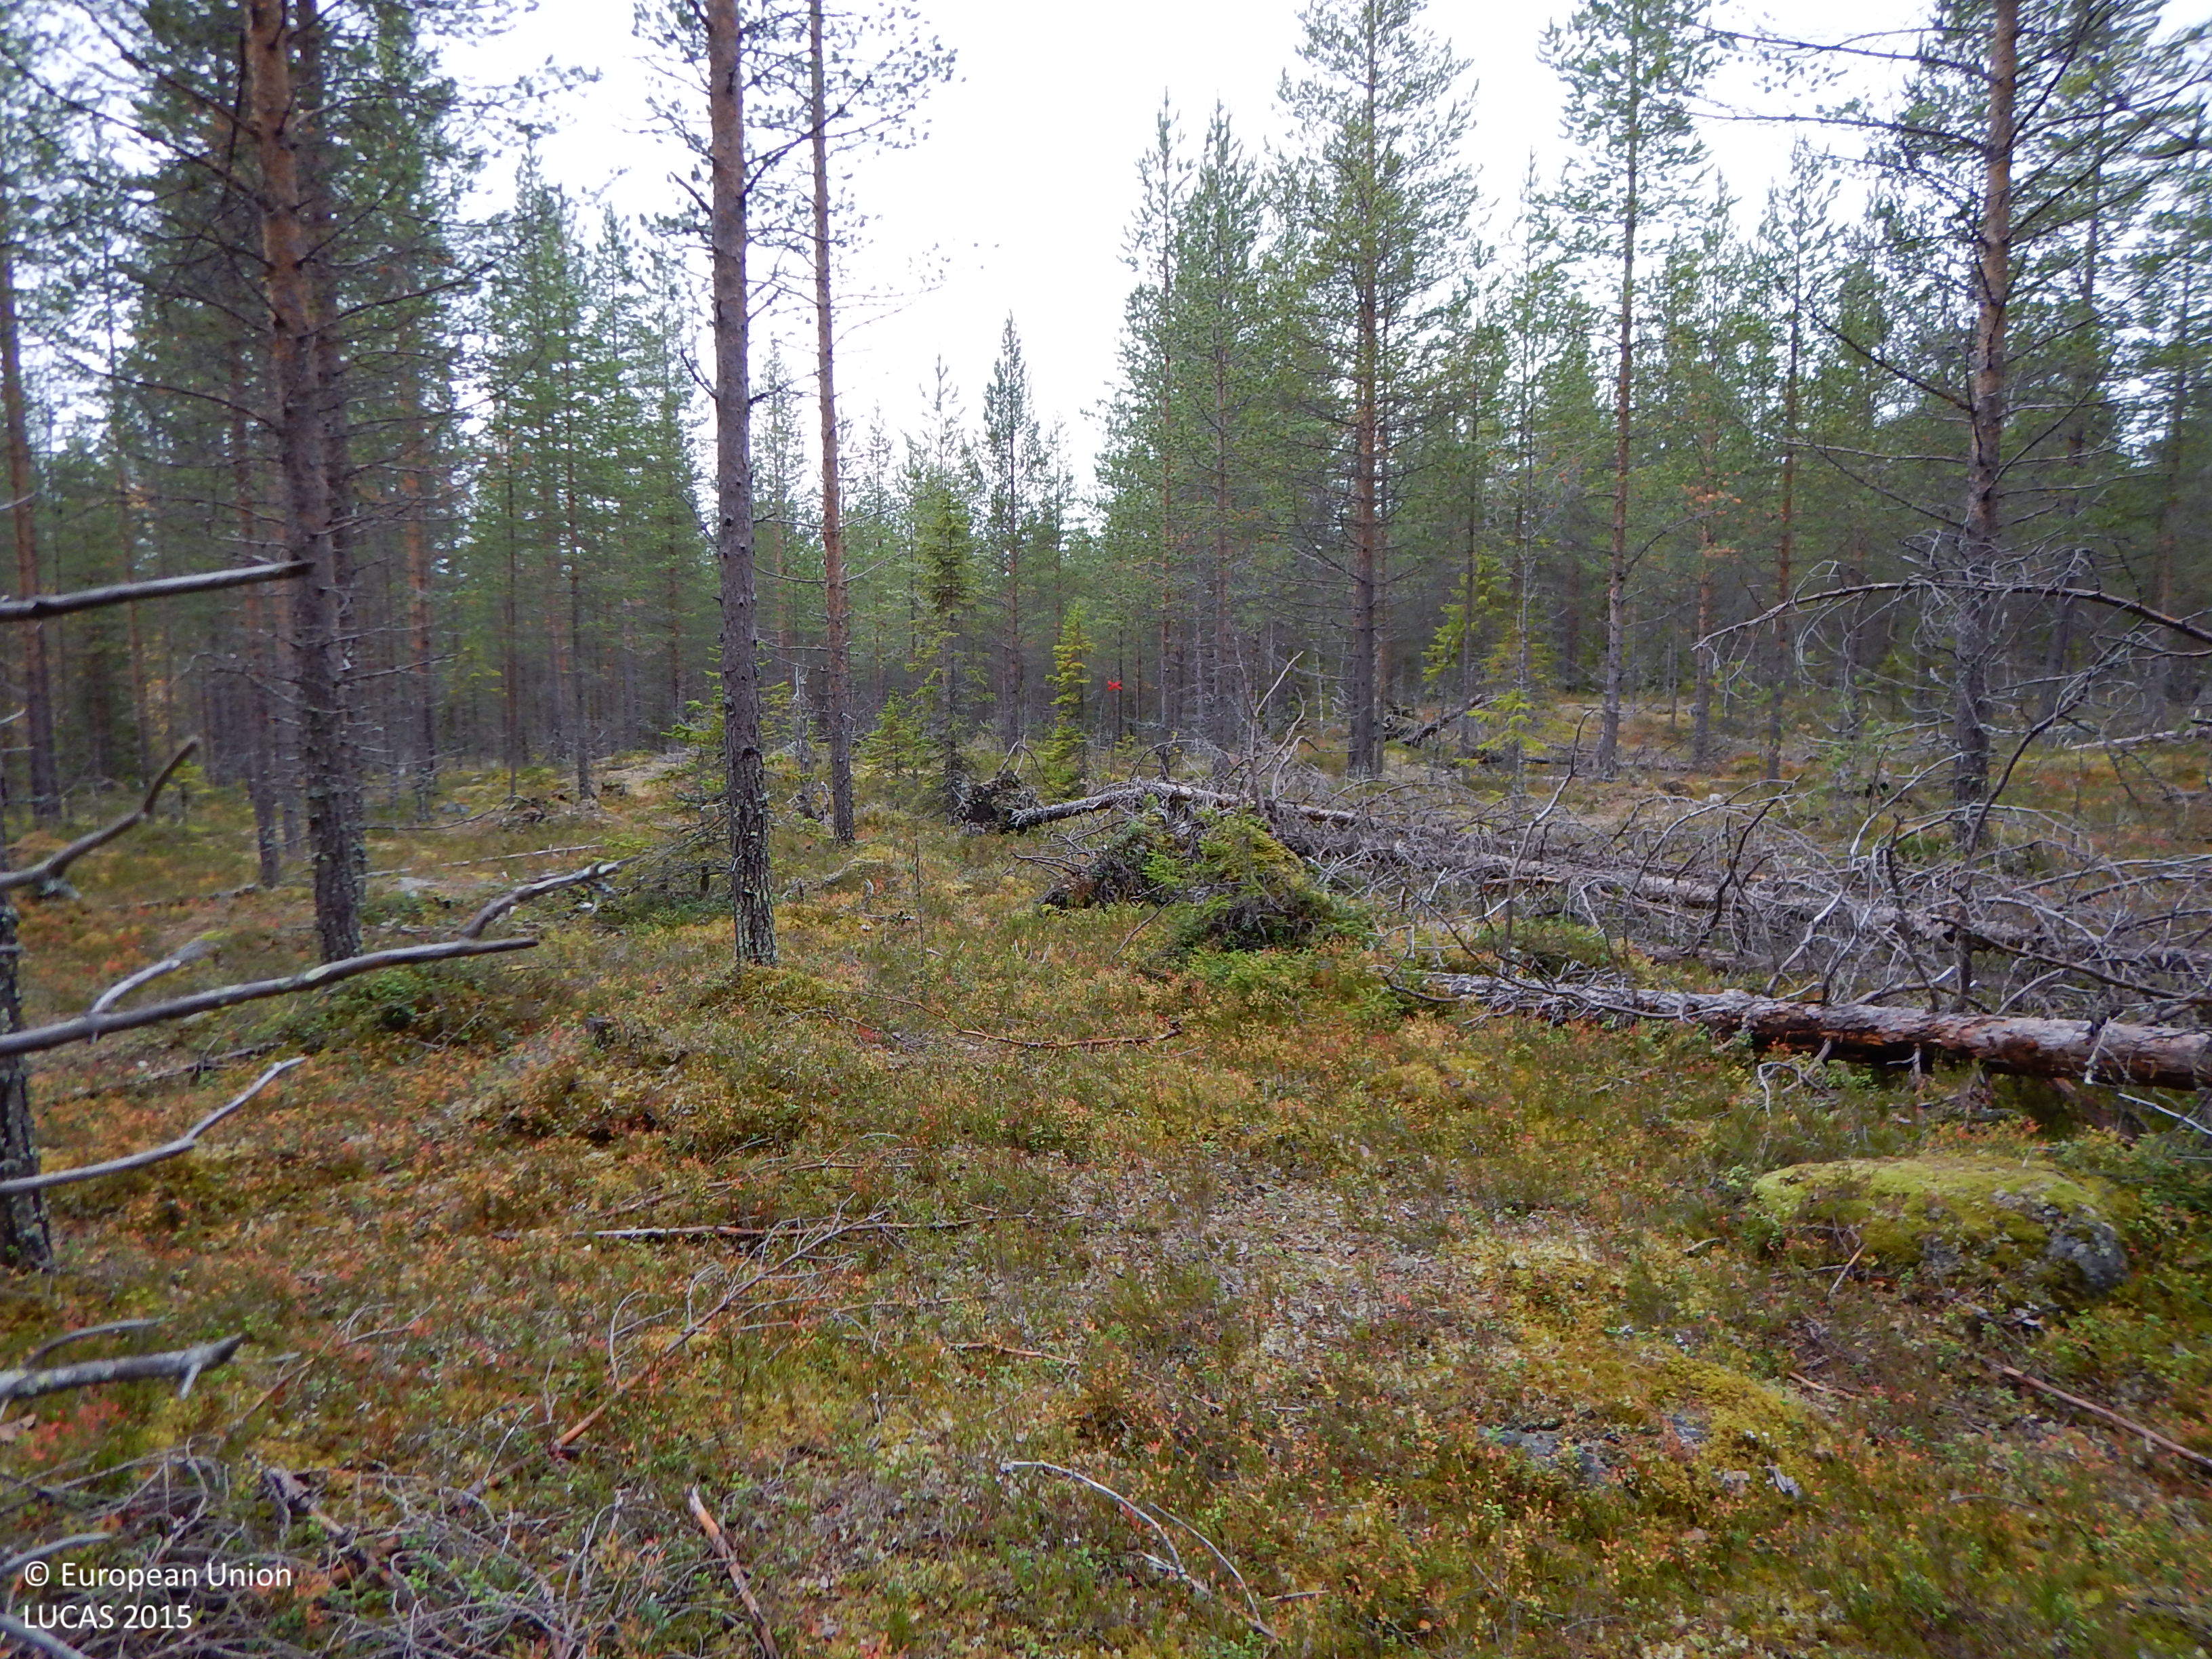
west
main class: Woodland
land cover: Pine dominated coniferous woodland
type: boreal forest
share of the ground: 50 - 75 %
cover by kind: coniferous forest trees 65 %, shrubs 15 %, lichens and mosses 15 %, herbaceous plants 5 %
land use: Forestry
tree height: > 5 m
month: September
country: SE
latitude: 65.0743
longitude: 19.2586
